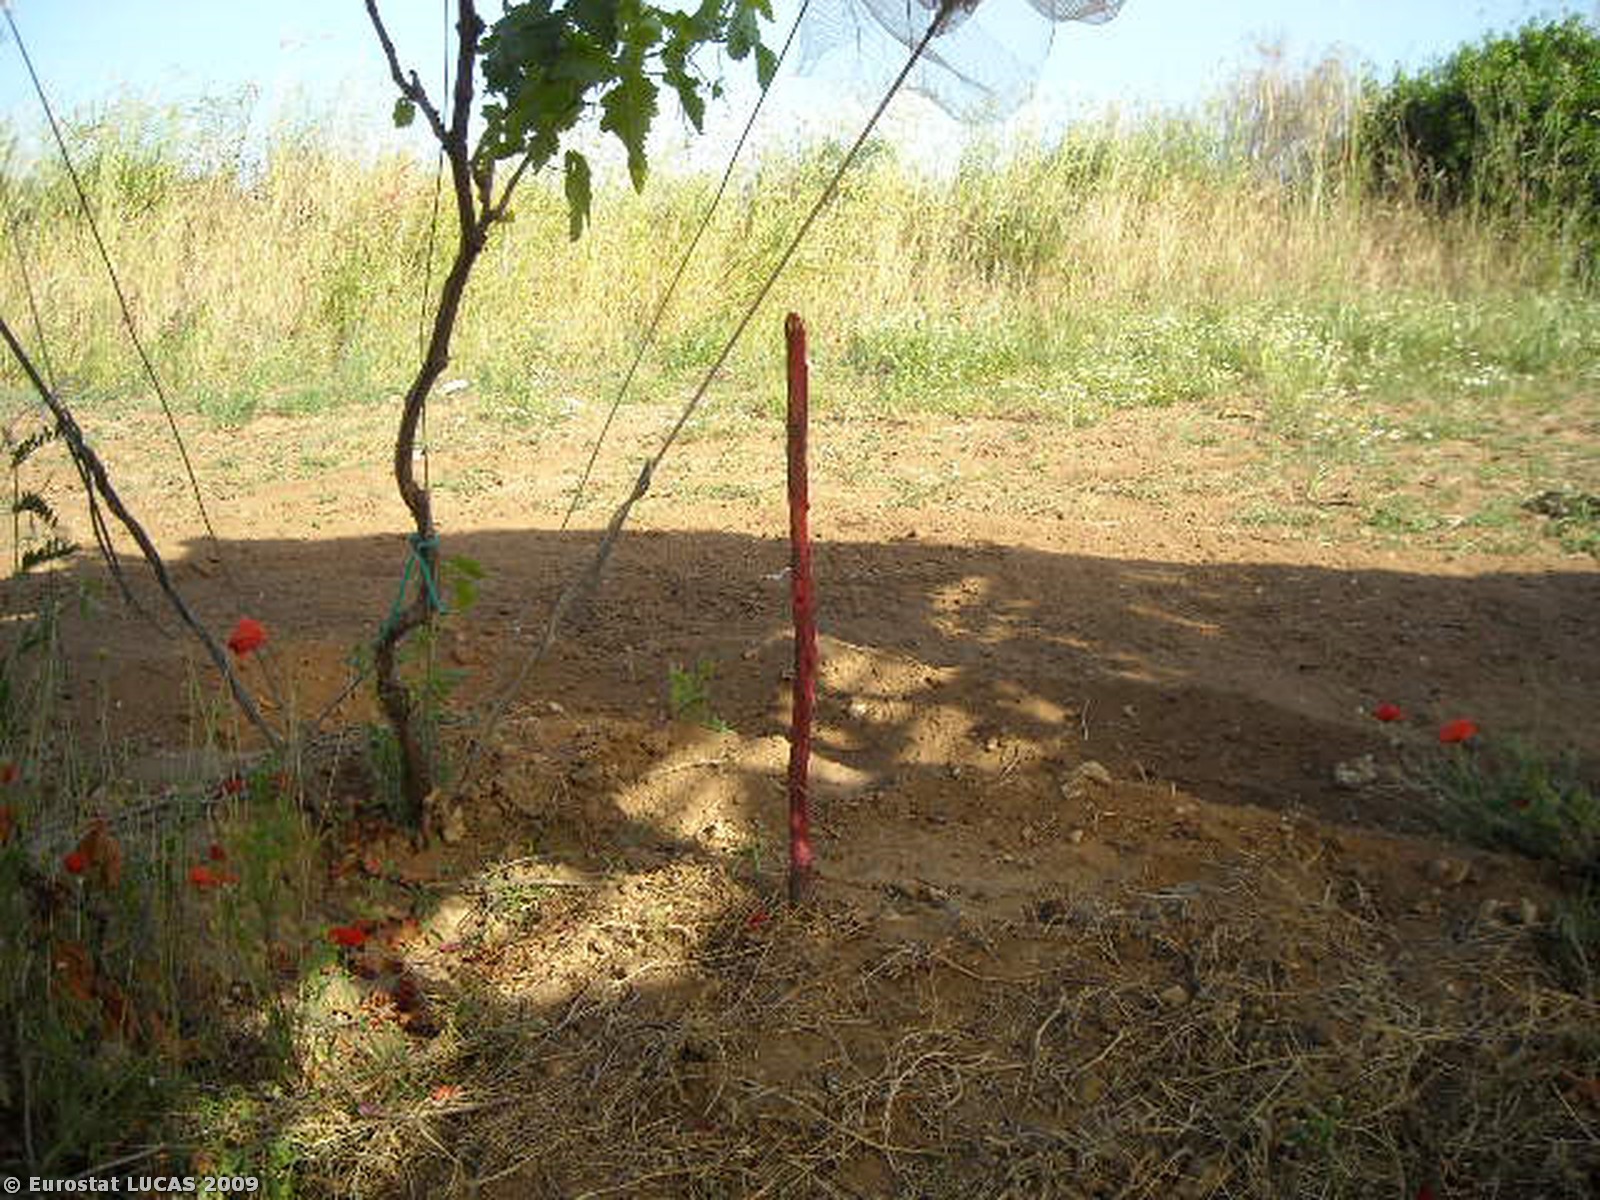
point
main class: Cropland
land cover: Vineyards
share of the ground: > 75 %
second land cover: Bare land
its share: > 75 %
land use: Agriculture (excluding fallow land and kitchen gardens)
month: May
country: IT
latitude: 40.4650
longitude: 16.8277
